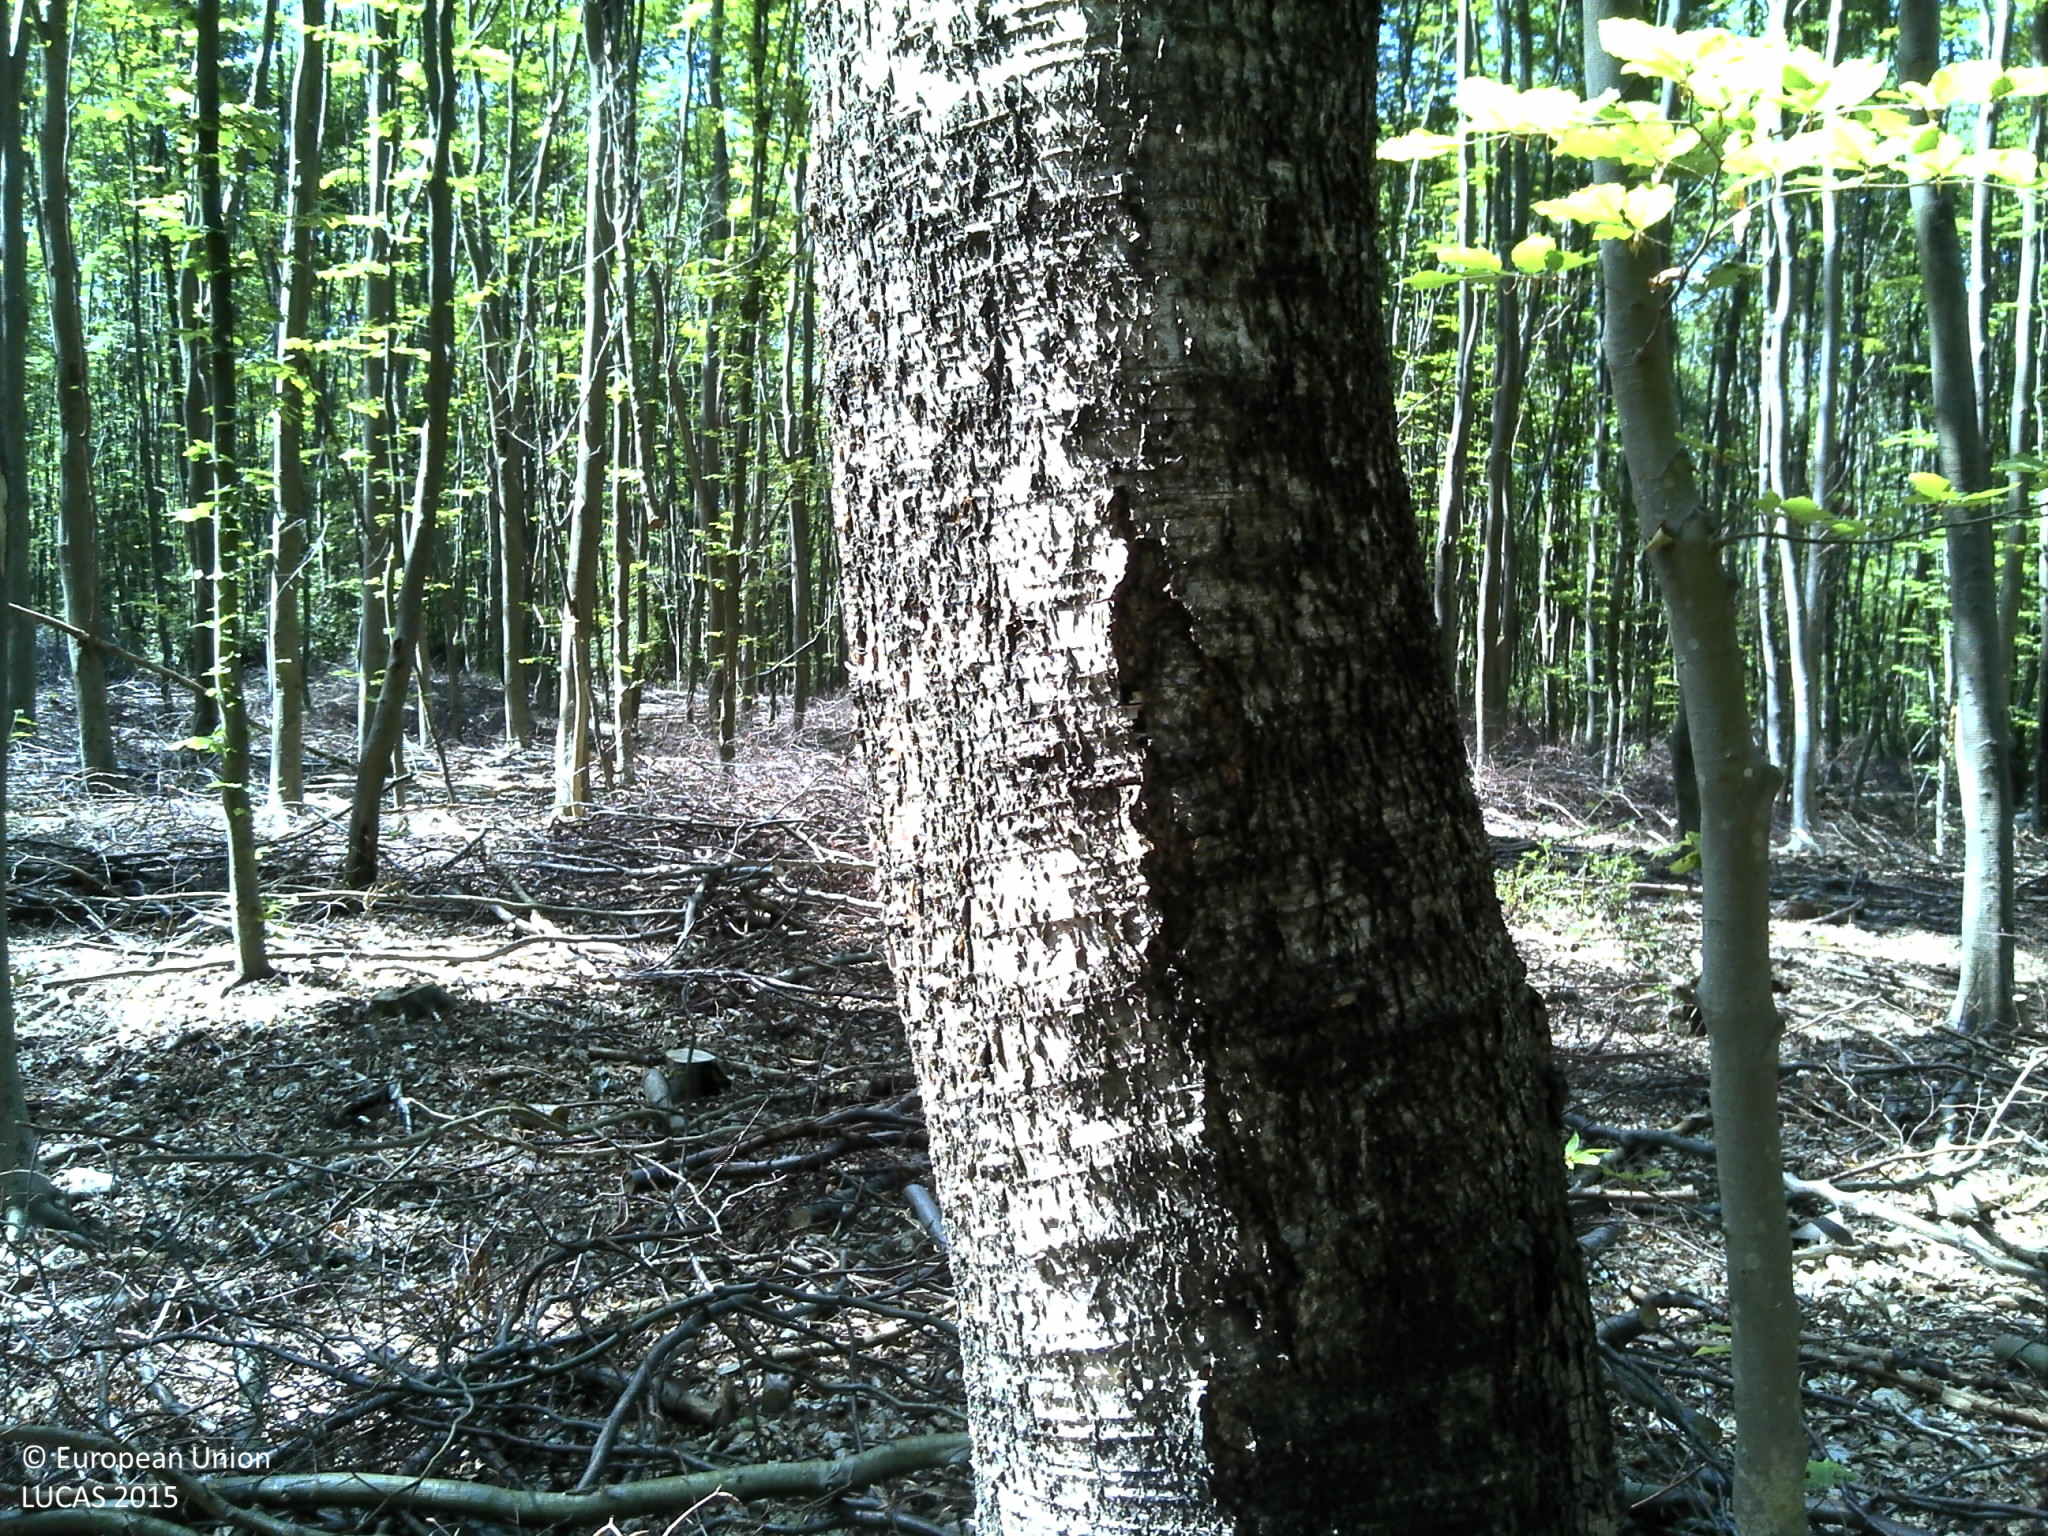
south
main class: Woodland
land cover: Broadleaved woodland
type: beech forest
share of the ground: > 75 %
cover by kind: broadleaved forest trees 90 %, consolidated bare surface 10 %
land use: Forestry
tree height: > 5 m
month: June
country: FR
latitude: 49.5098
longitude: 1.0982
